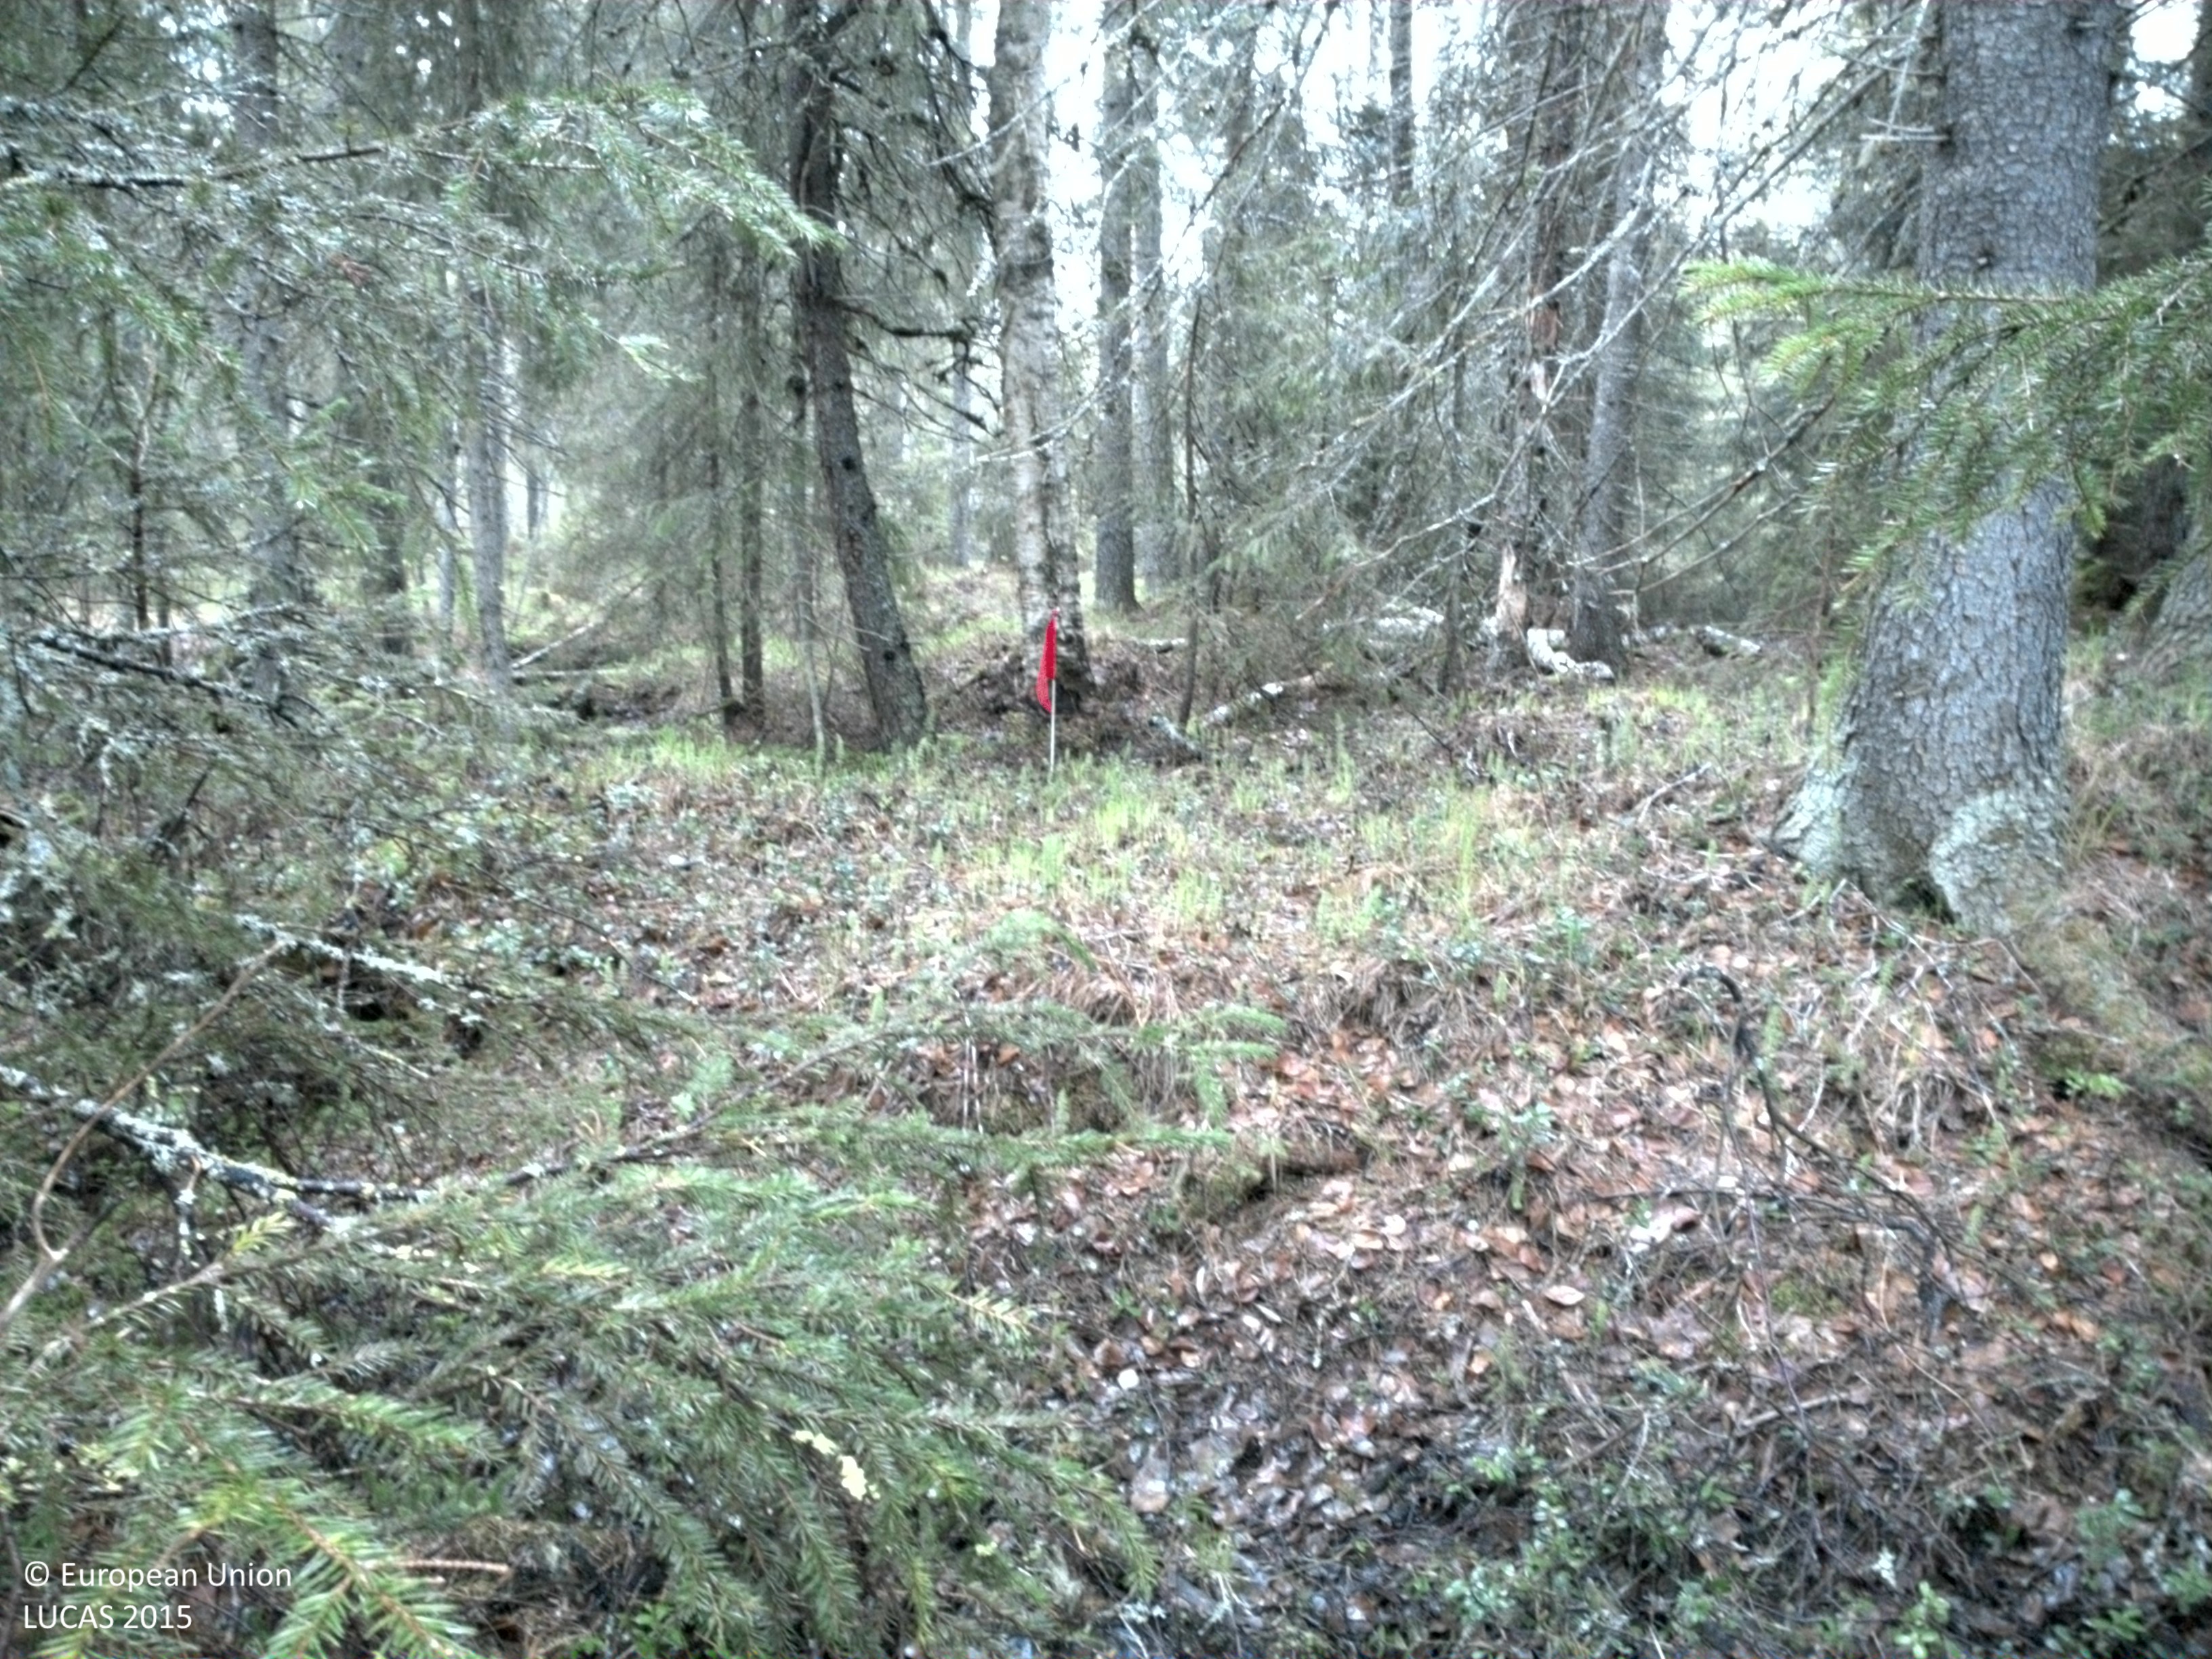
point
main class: Woodland
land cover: Spruce dominated coniferous woodland
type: boreal forest
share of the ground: 50 - 75 %
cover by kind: coniferous forest trees 65 %, shrubs 15 %, herbaceous plants 10 %, broadleaved forest trees 5 %, lichens and mosses 5 %
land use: Forestry
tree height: > 5 m
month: June
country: SE
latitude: 66.0273
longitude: 23.0197
